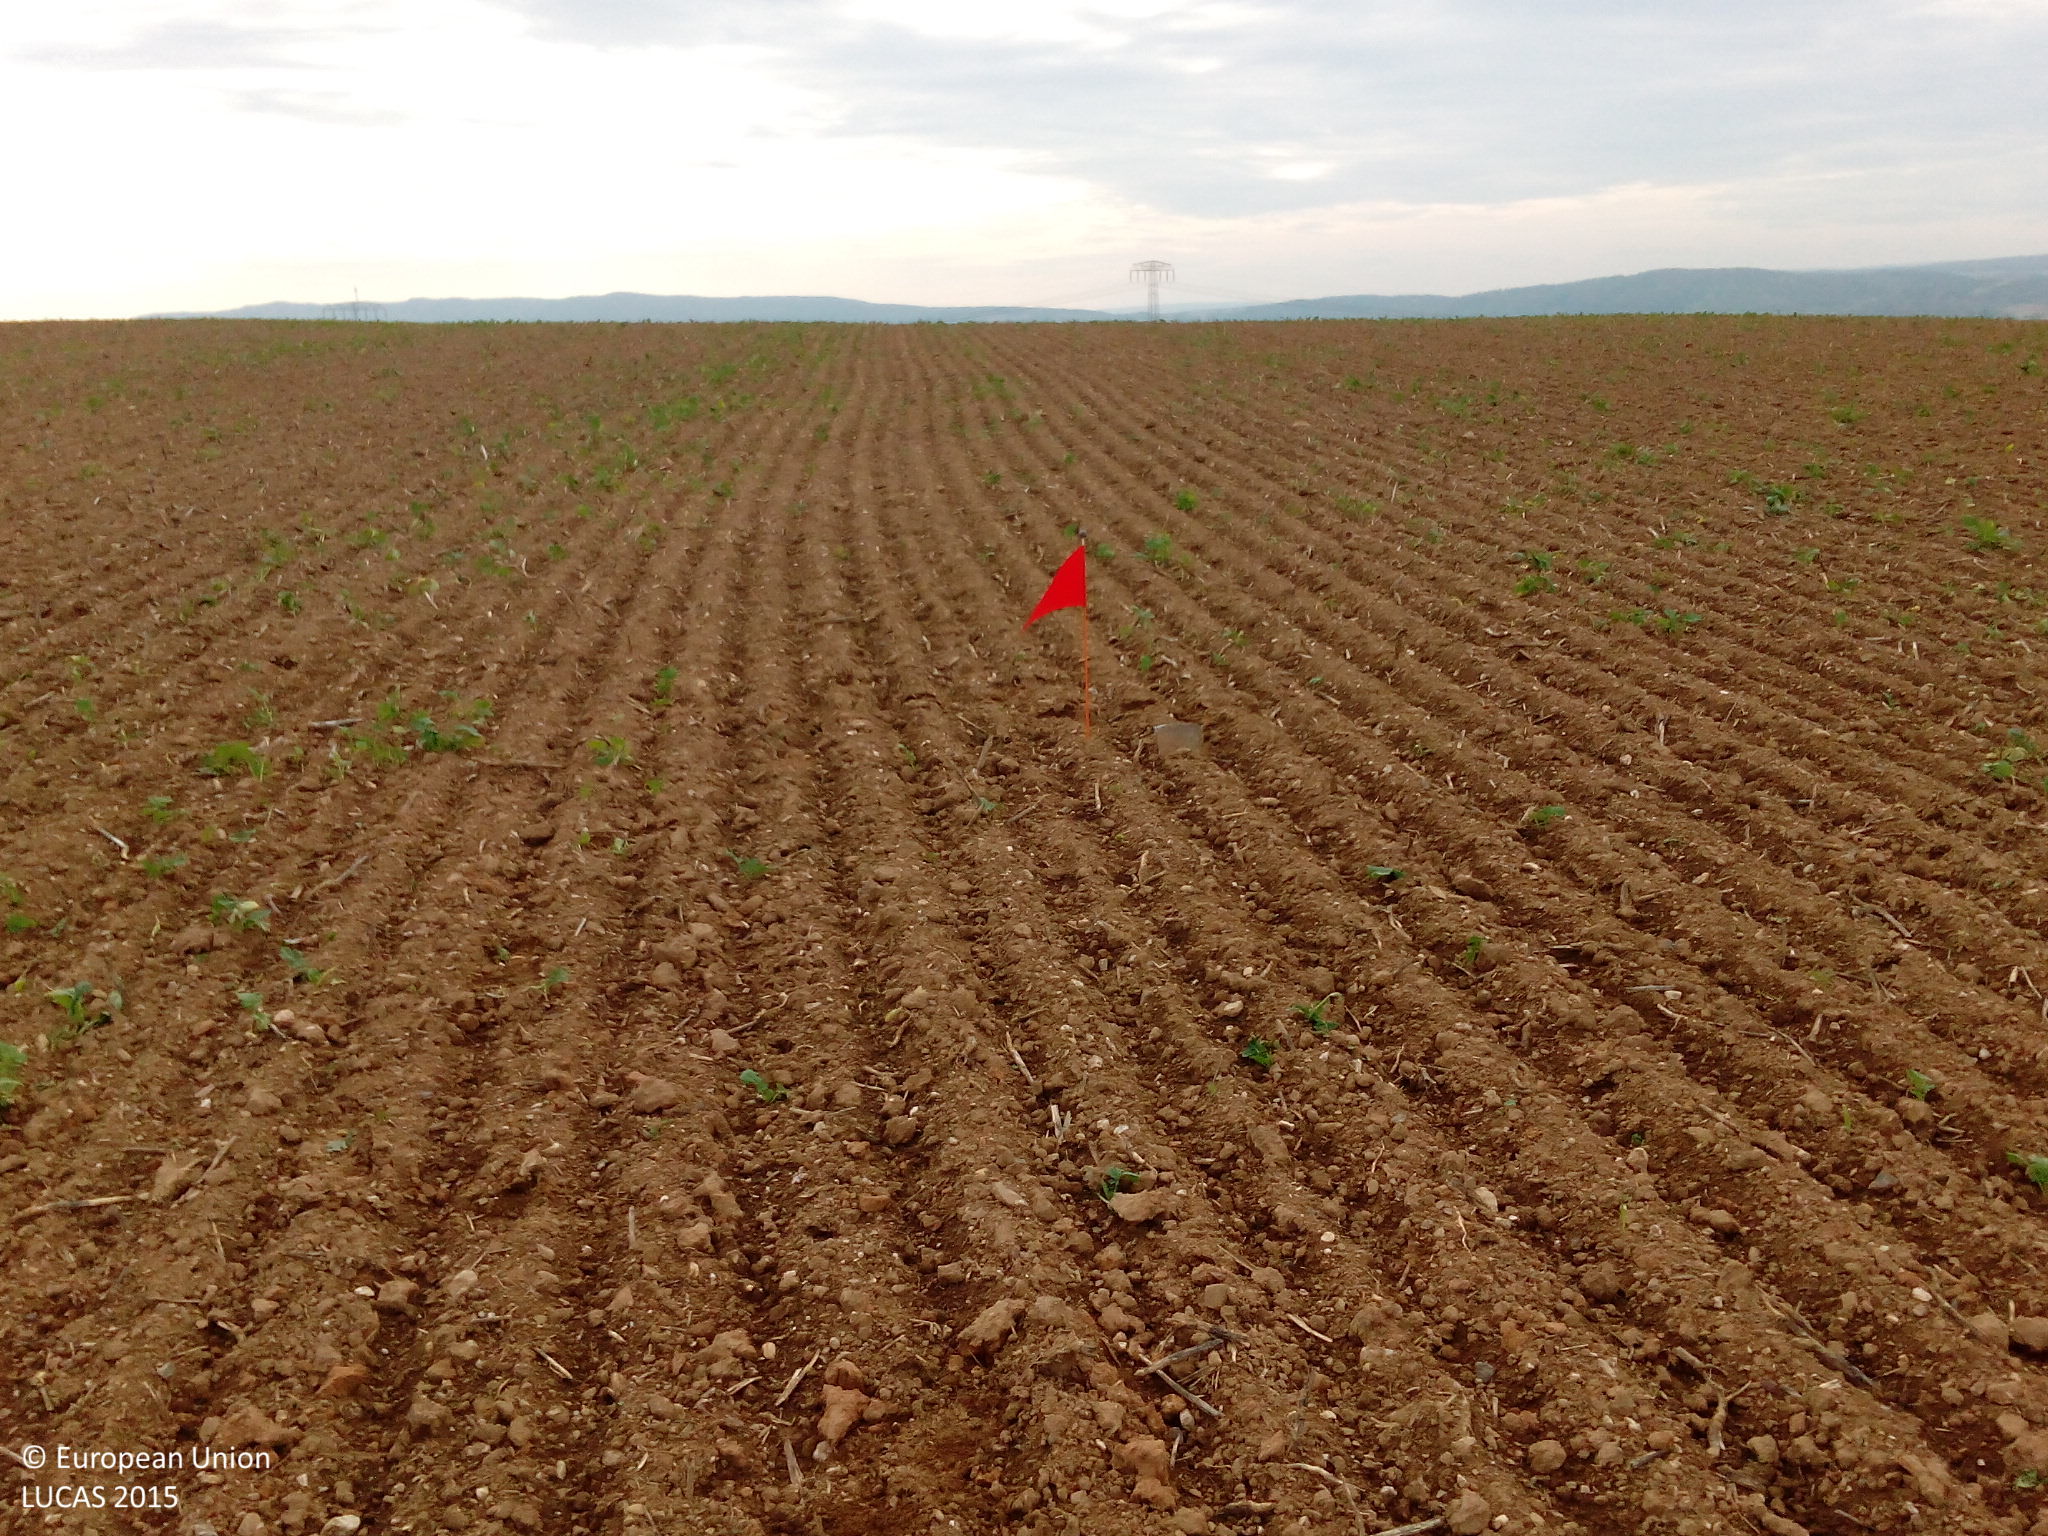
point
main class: Cropland
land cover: Rape and turnip rape
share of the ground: < 10 %
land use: Agriculture (excluding fallow land and kitchen gardens)
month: September
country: DE
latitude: 51.4747
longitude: 10.9643
